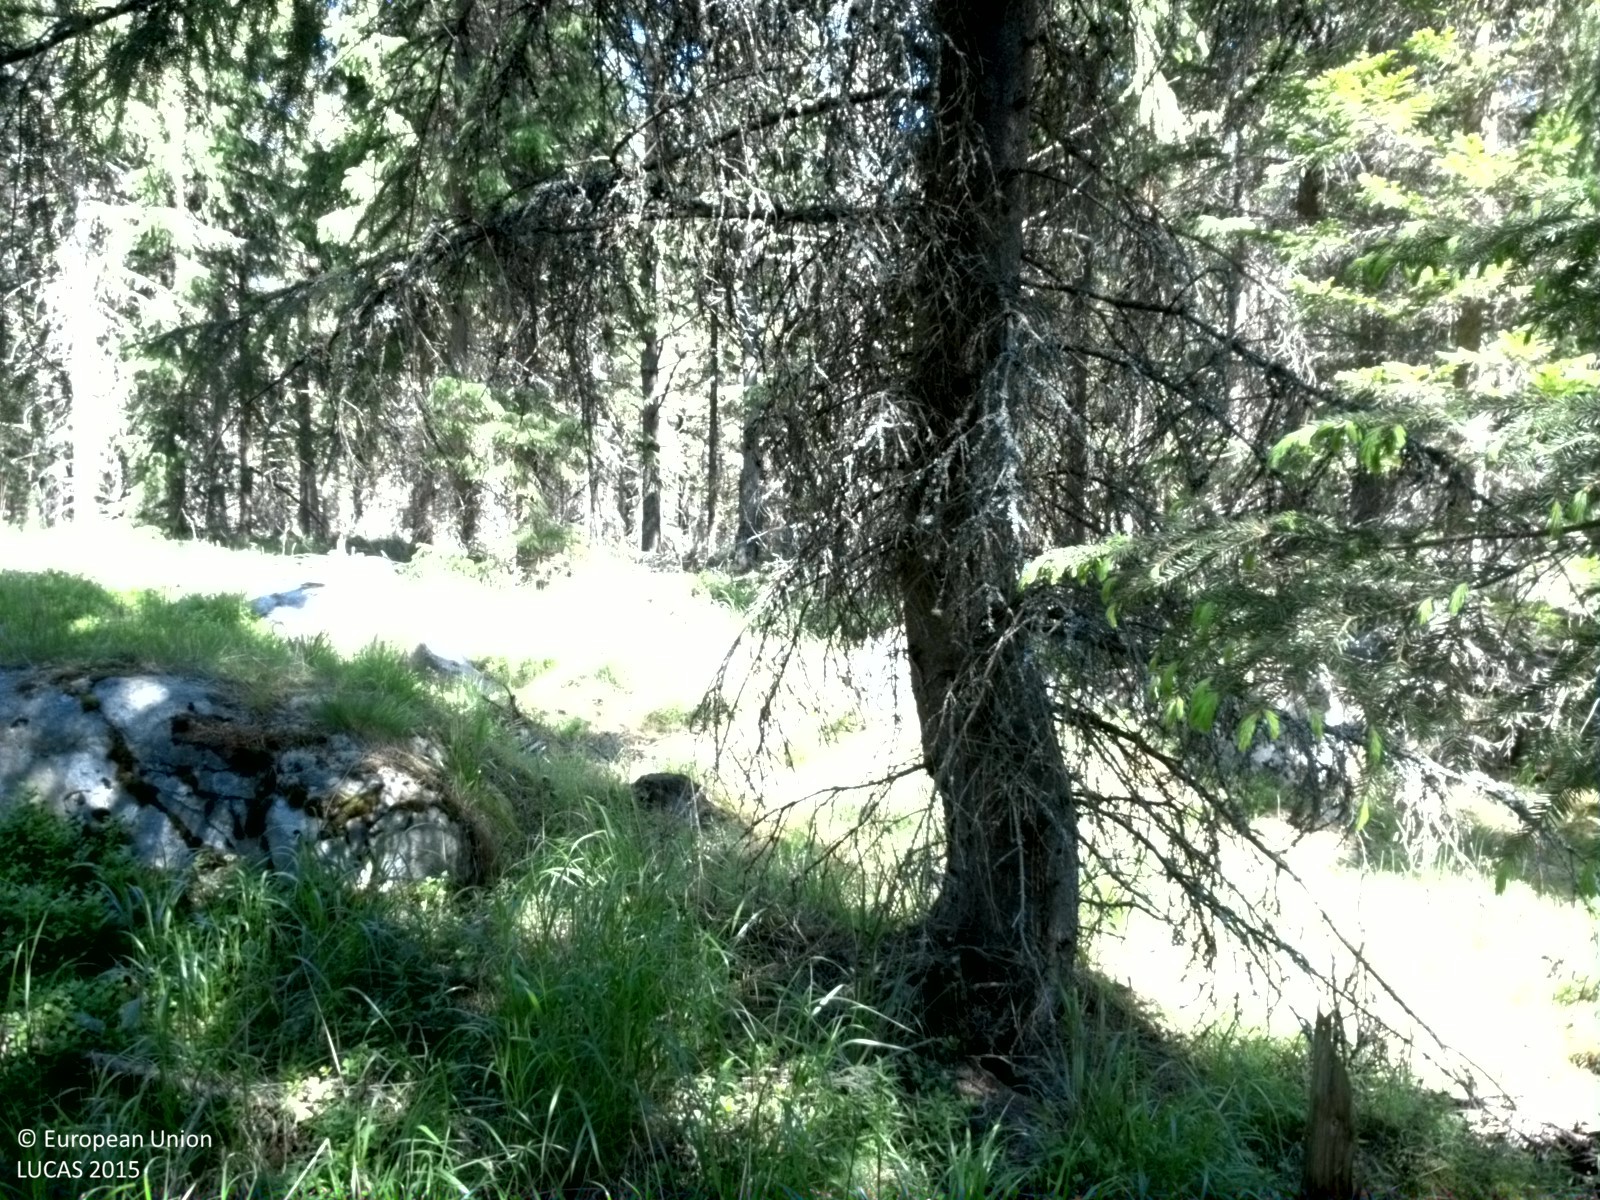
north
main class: Woodland
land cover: Spruce dominated coniferous woodland
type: boreal forest
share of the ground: > 75 %
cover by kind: coniferous forest trees 75 %, herbaceous plants 10 %, shrubs 5 %, lichens and mosses 5 %, consolidated bare surface 5 %
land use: Forestry
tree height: > 5 m
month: June
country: SE
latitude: 60.2670
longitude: 17.5661
